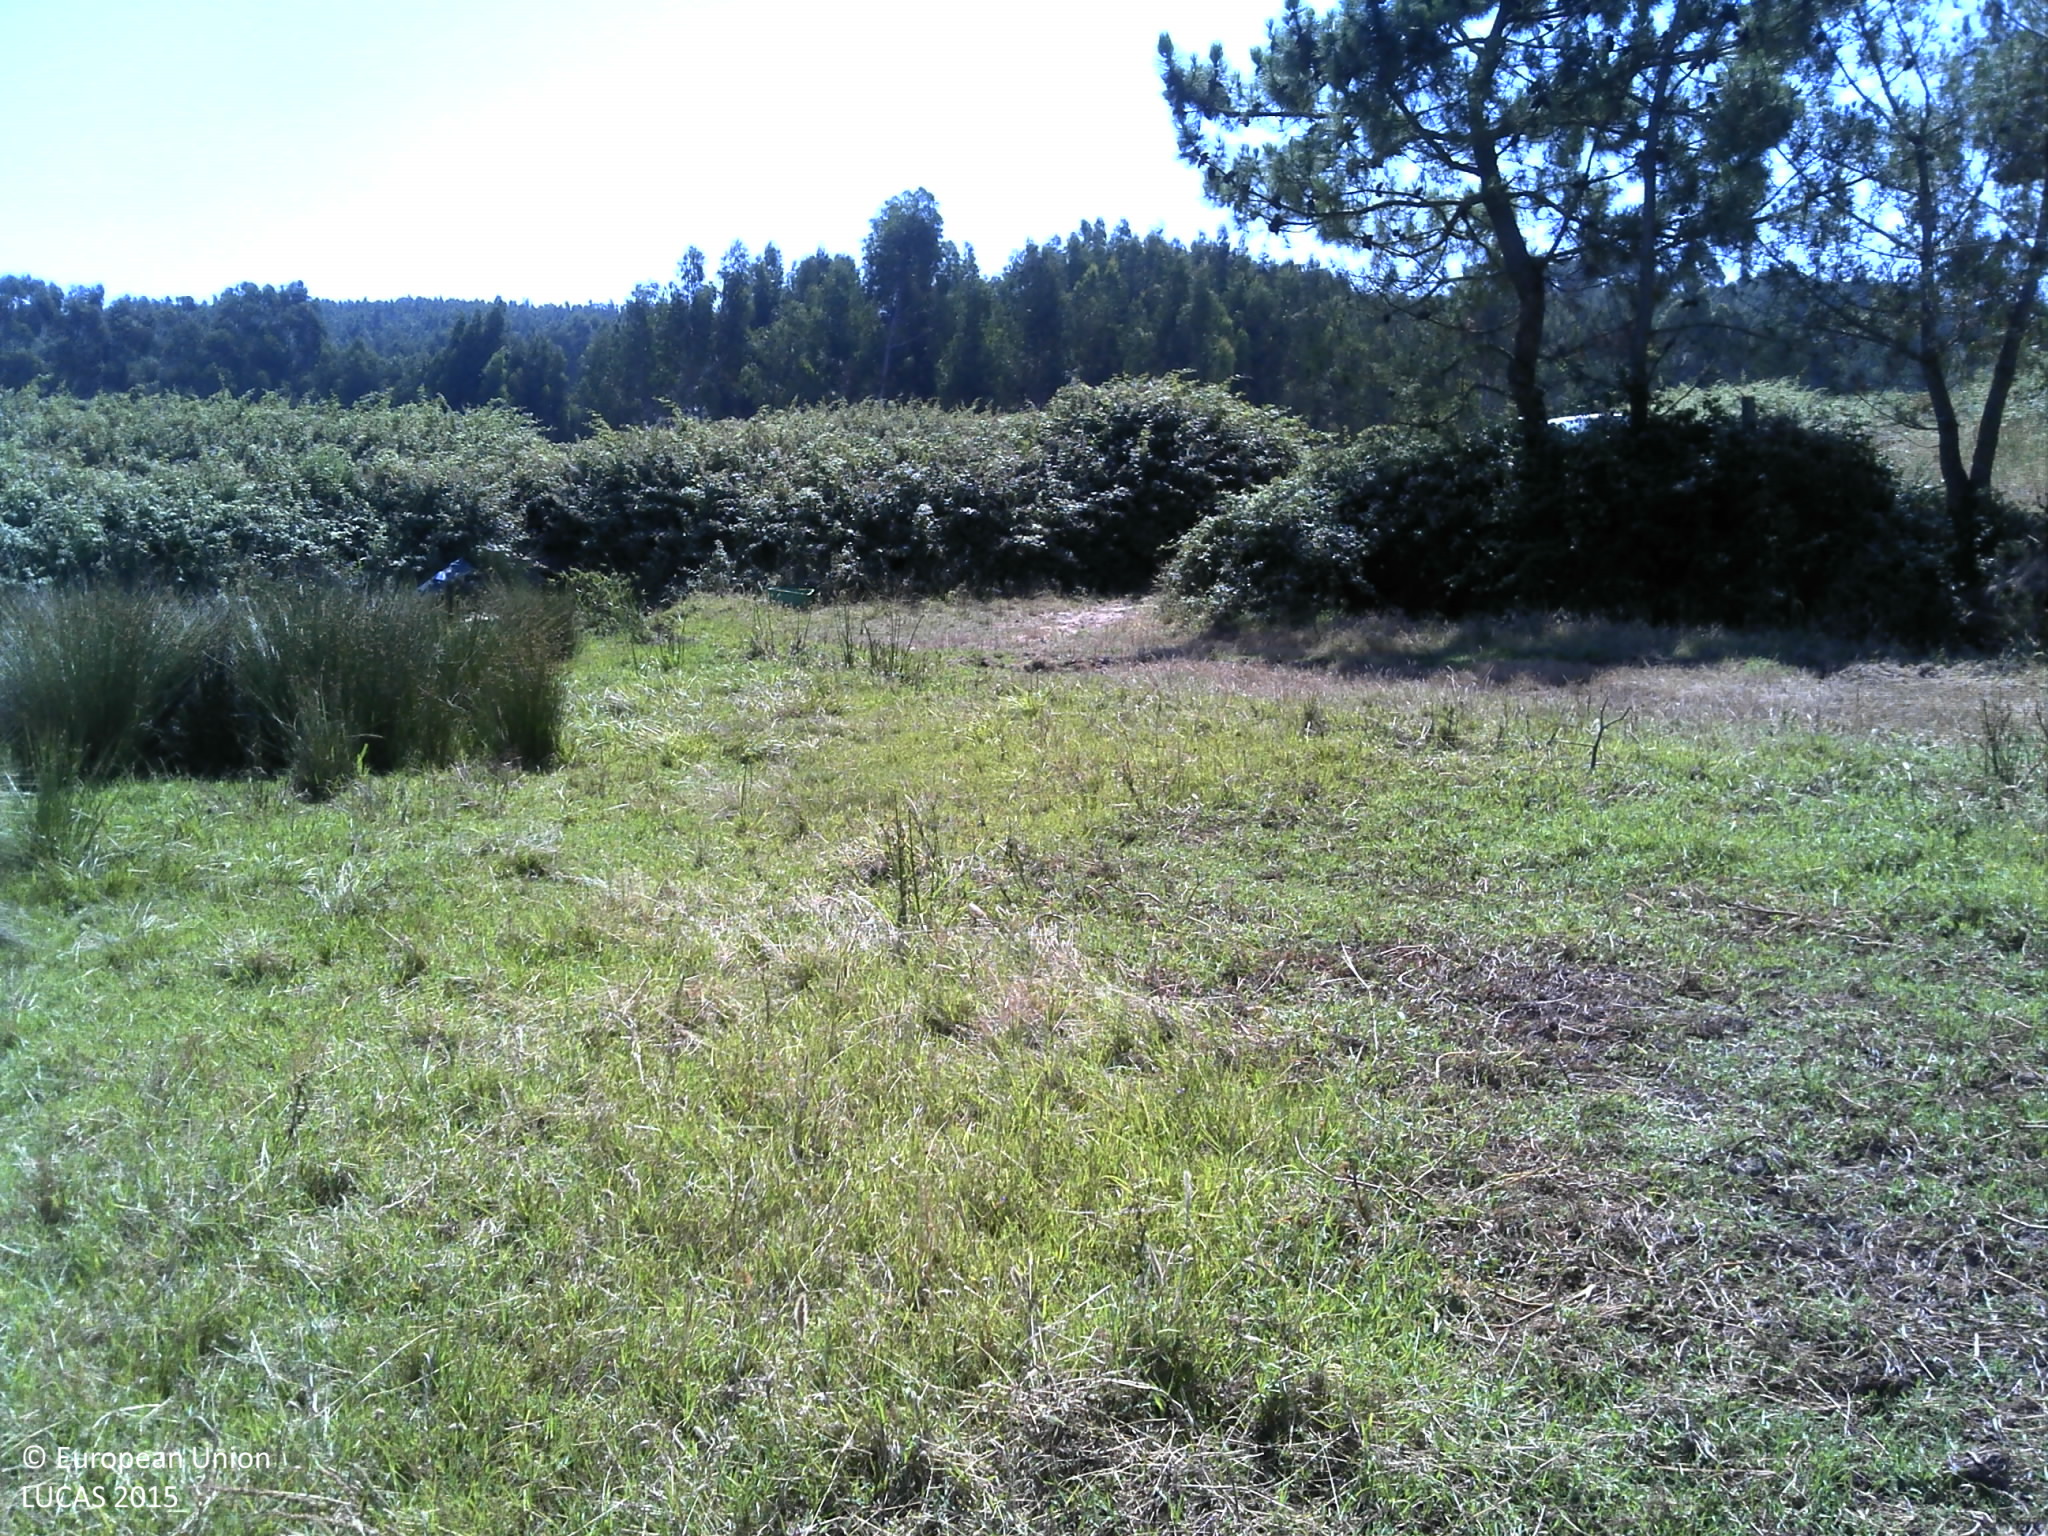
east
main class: Grassland
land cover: Grassland without tree/shrub cover
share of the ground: 50 - 75 %
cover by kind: herbaceous plants 55 %, unconsolidated bare surface 40 %, shrubs 5 %
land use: Agriculture (excluding fallow land and kitchen gardens)
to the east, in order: Grassland without tree/shrub cover; Shruby margins; Tracks; Shrubland without tree cover; Grassland without tree/shrub cover; Tracks; Broadleaved woodland; Grassland without tree/shrub cover; Inland fresh water bodies; Shrubland without tree cover; Inland fresh water bodies; Tracks
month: June
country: PT
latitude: 39.1097
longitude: -9.2965
